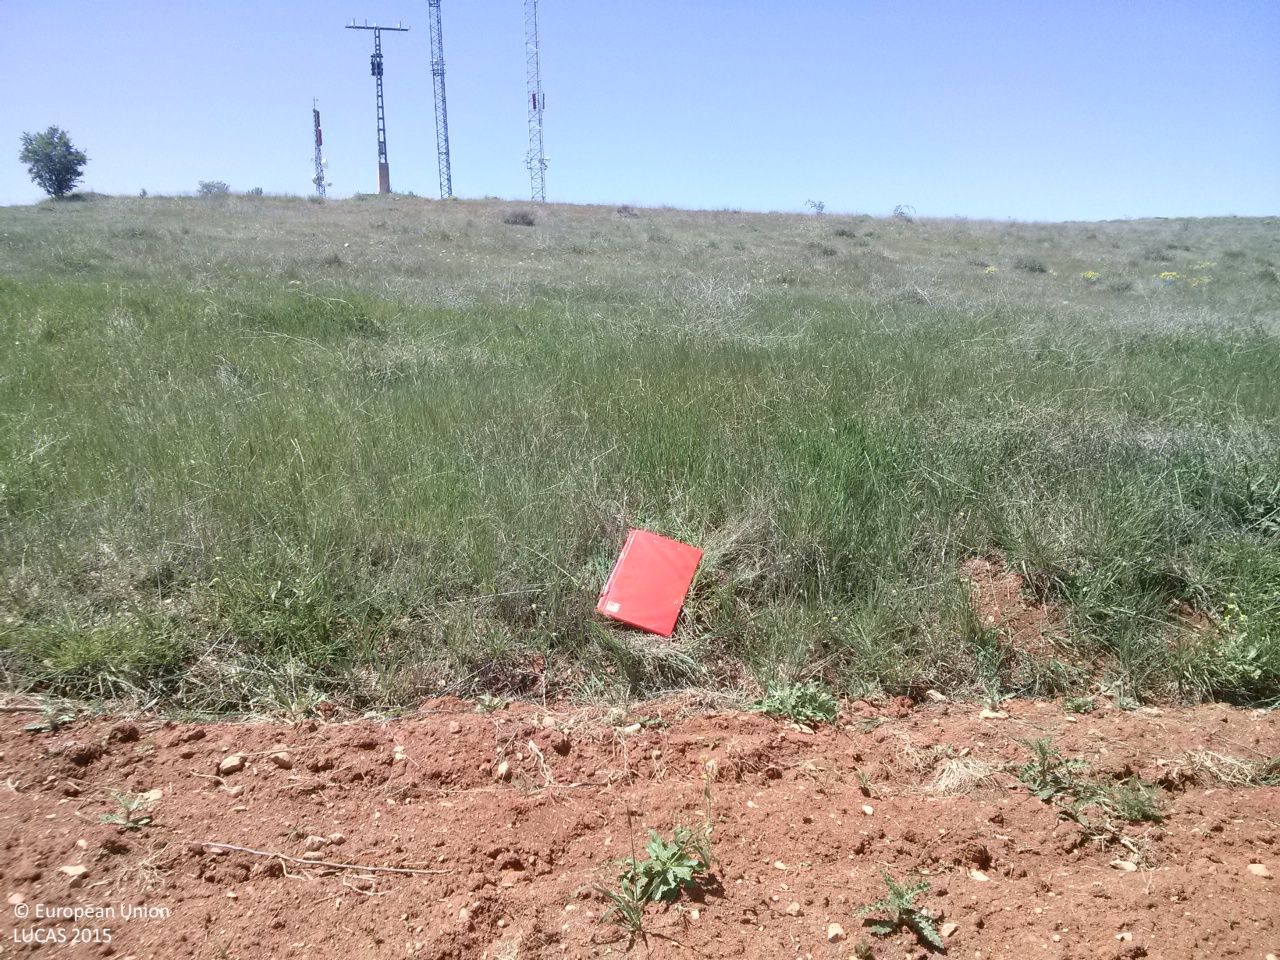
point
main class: Grassland
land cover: Spontaneously vegetated surfaces
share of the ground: 10 - 25 %
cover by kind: unconsolidated bare surface 85 %, herbaceous plants 15 %
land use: Fallow land
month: May
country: ES
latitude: 39.7846
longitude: -2.7103
